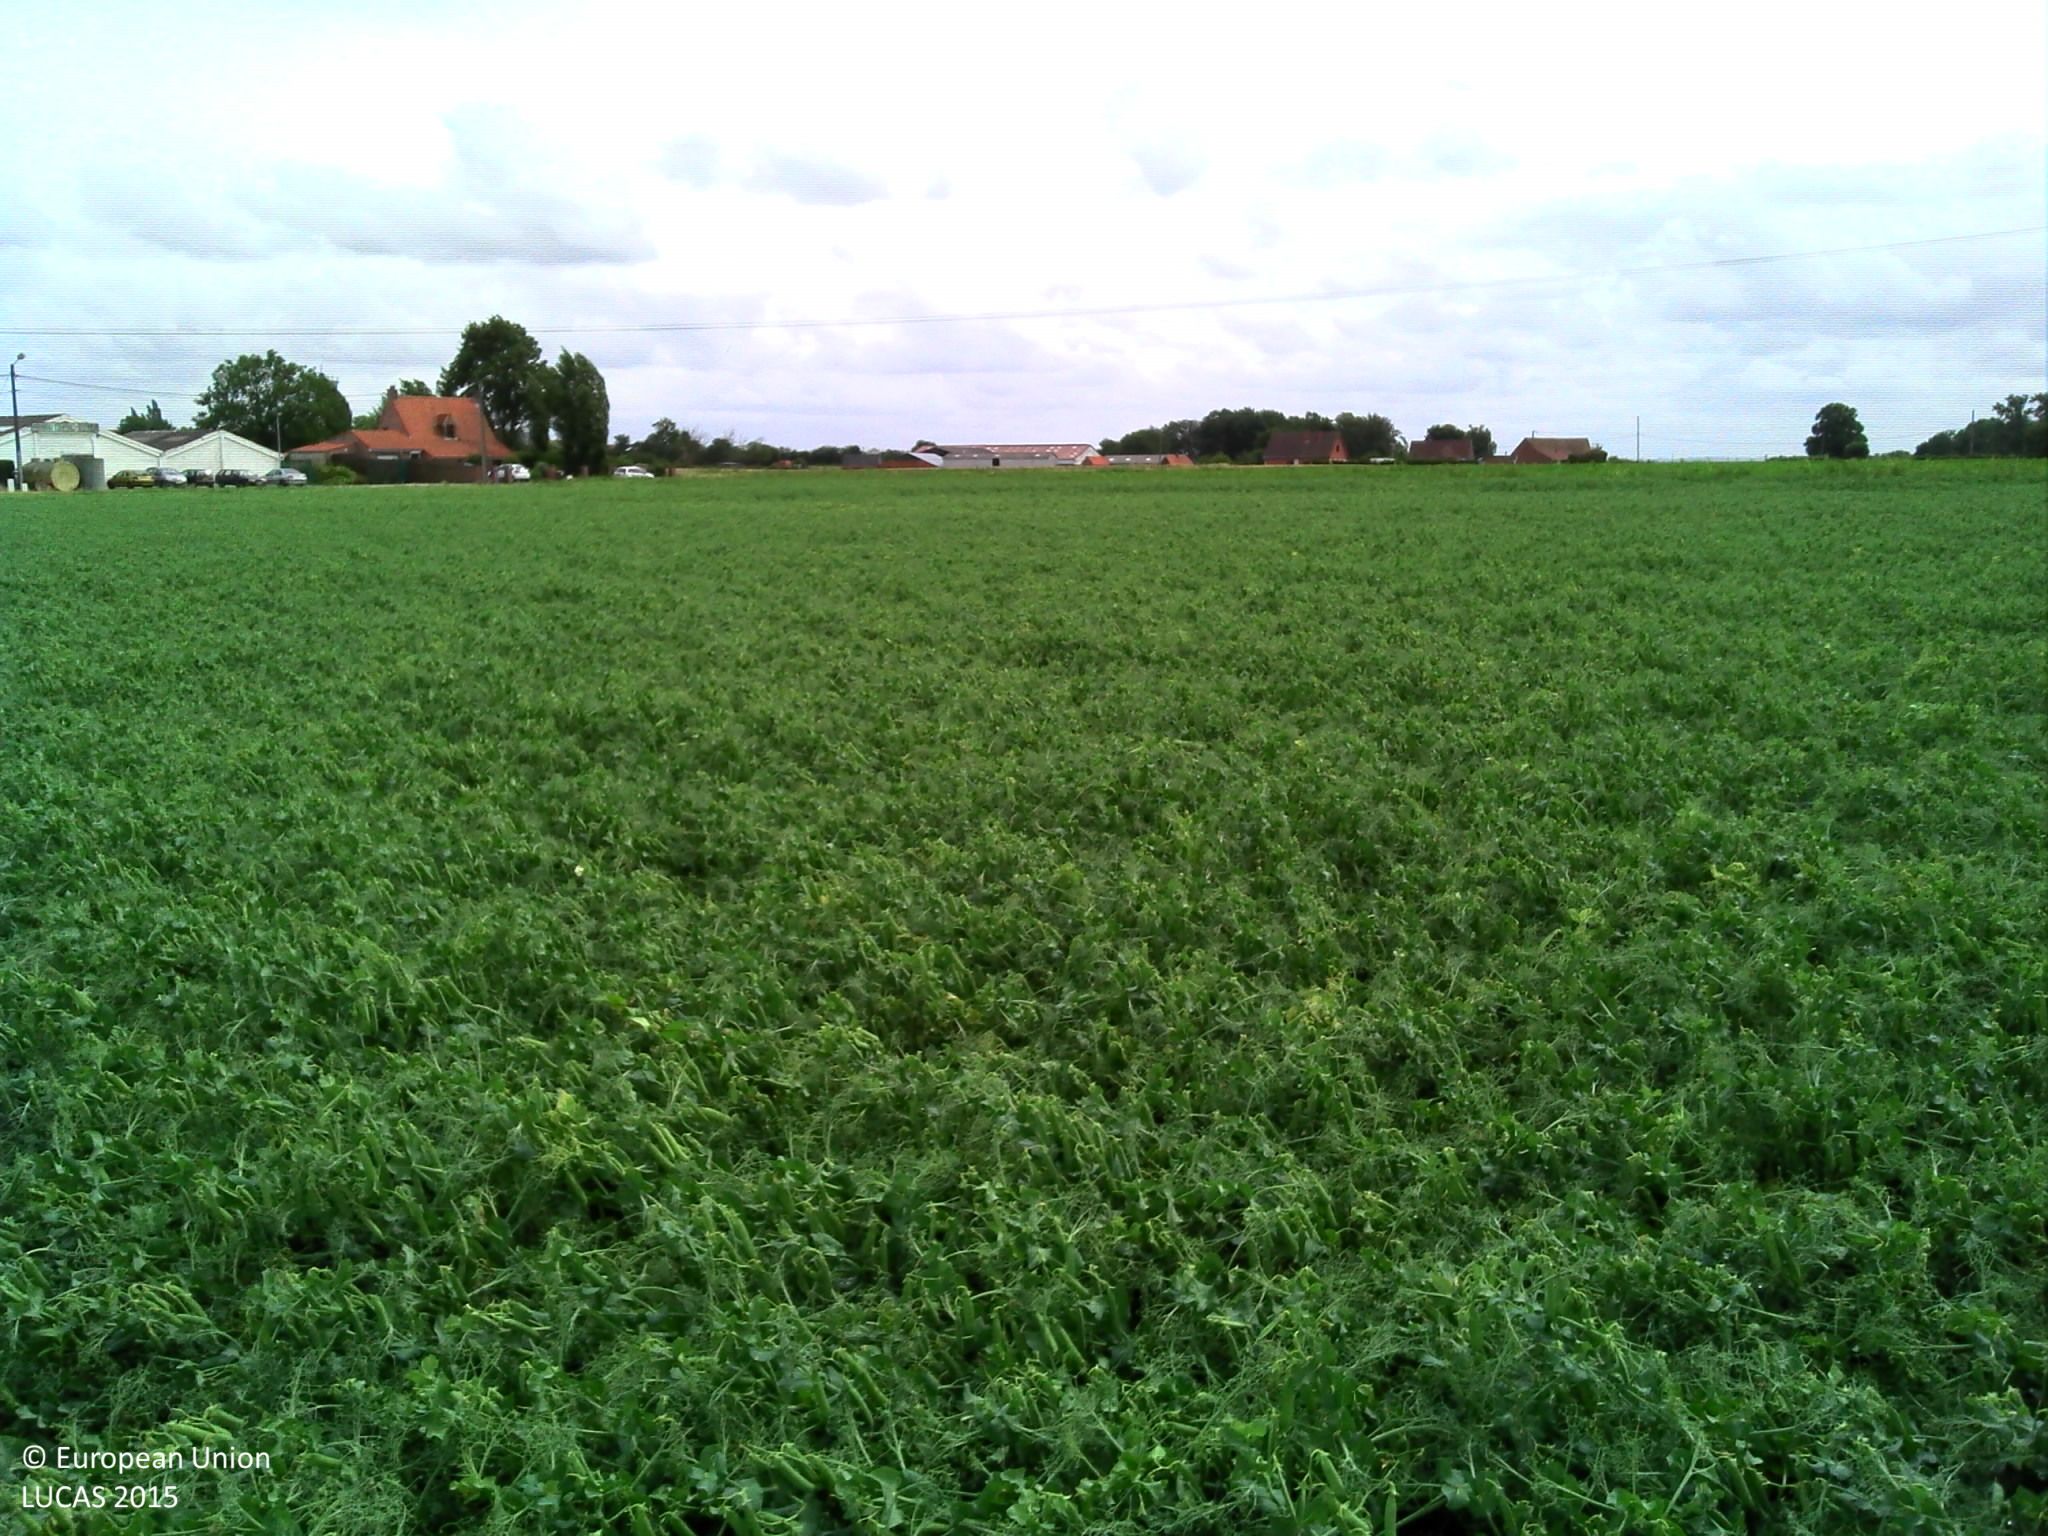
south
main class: Cropland
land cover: Dry pulses
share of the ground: > 75 %
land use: Agriculture (excluding fallow land and kitchen gardens)
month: July
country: FR
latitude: 50.7078
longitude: 2.4108
